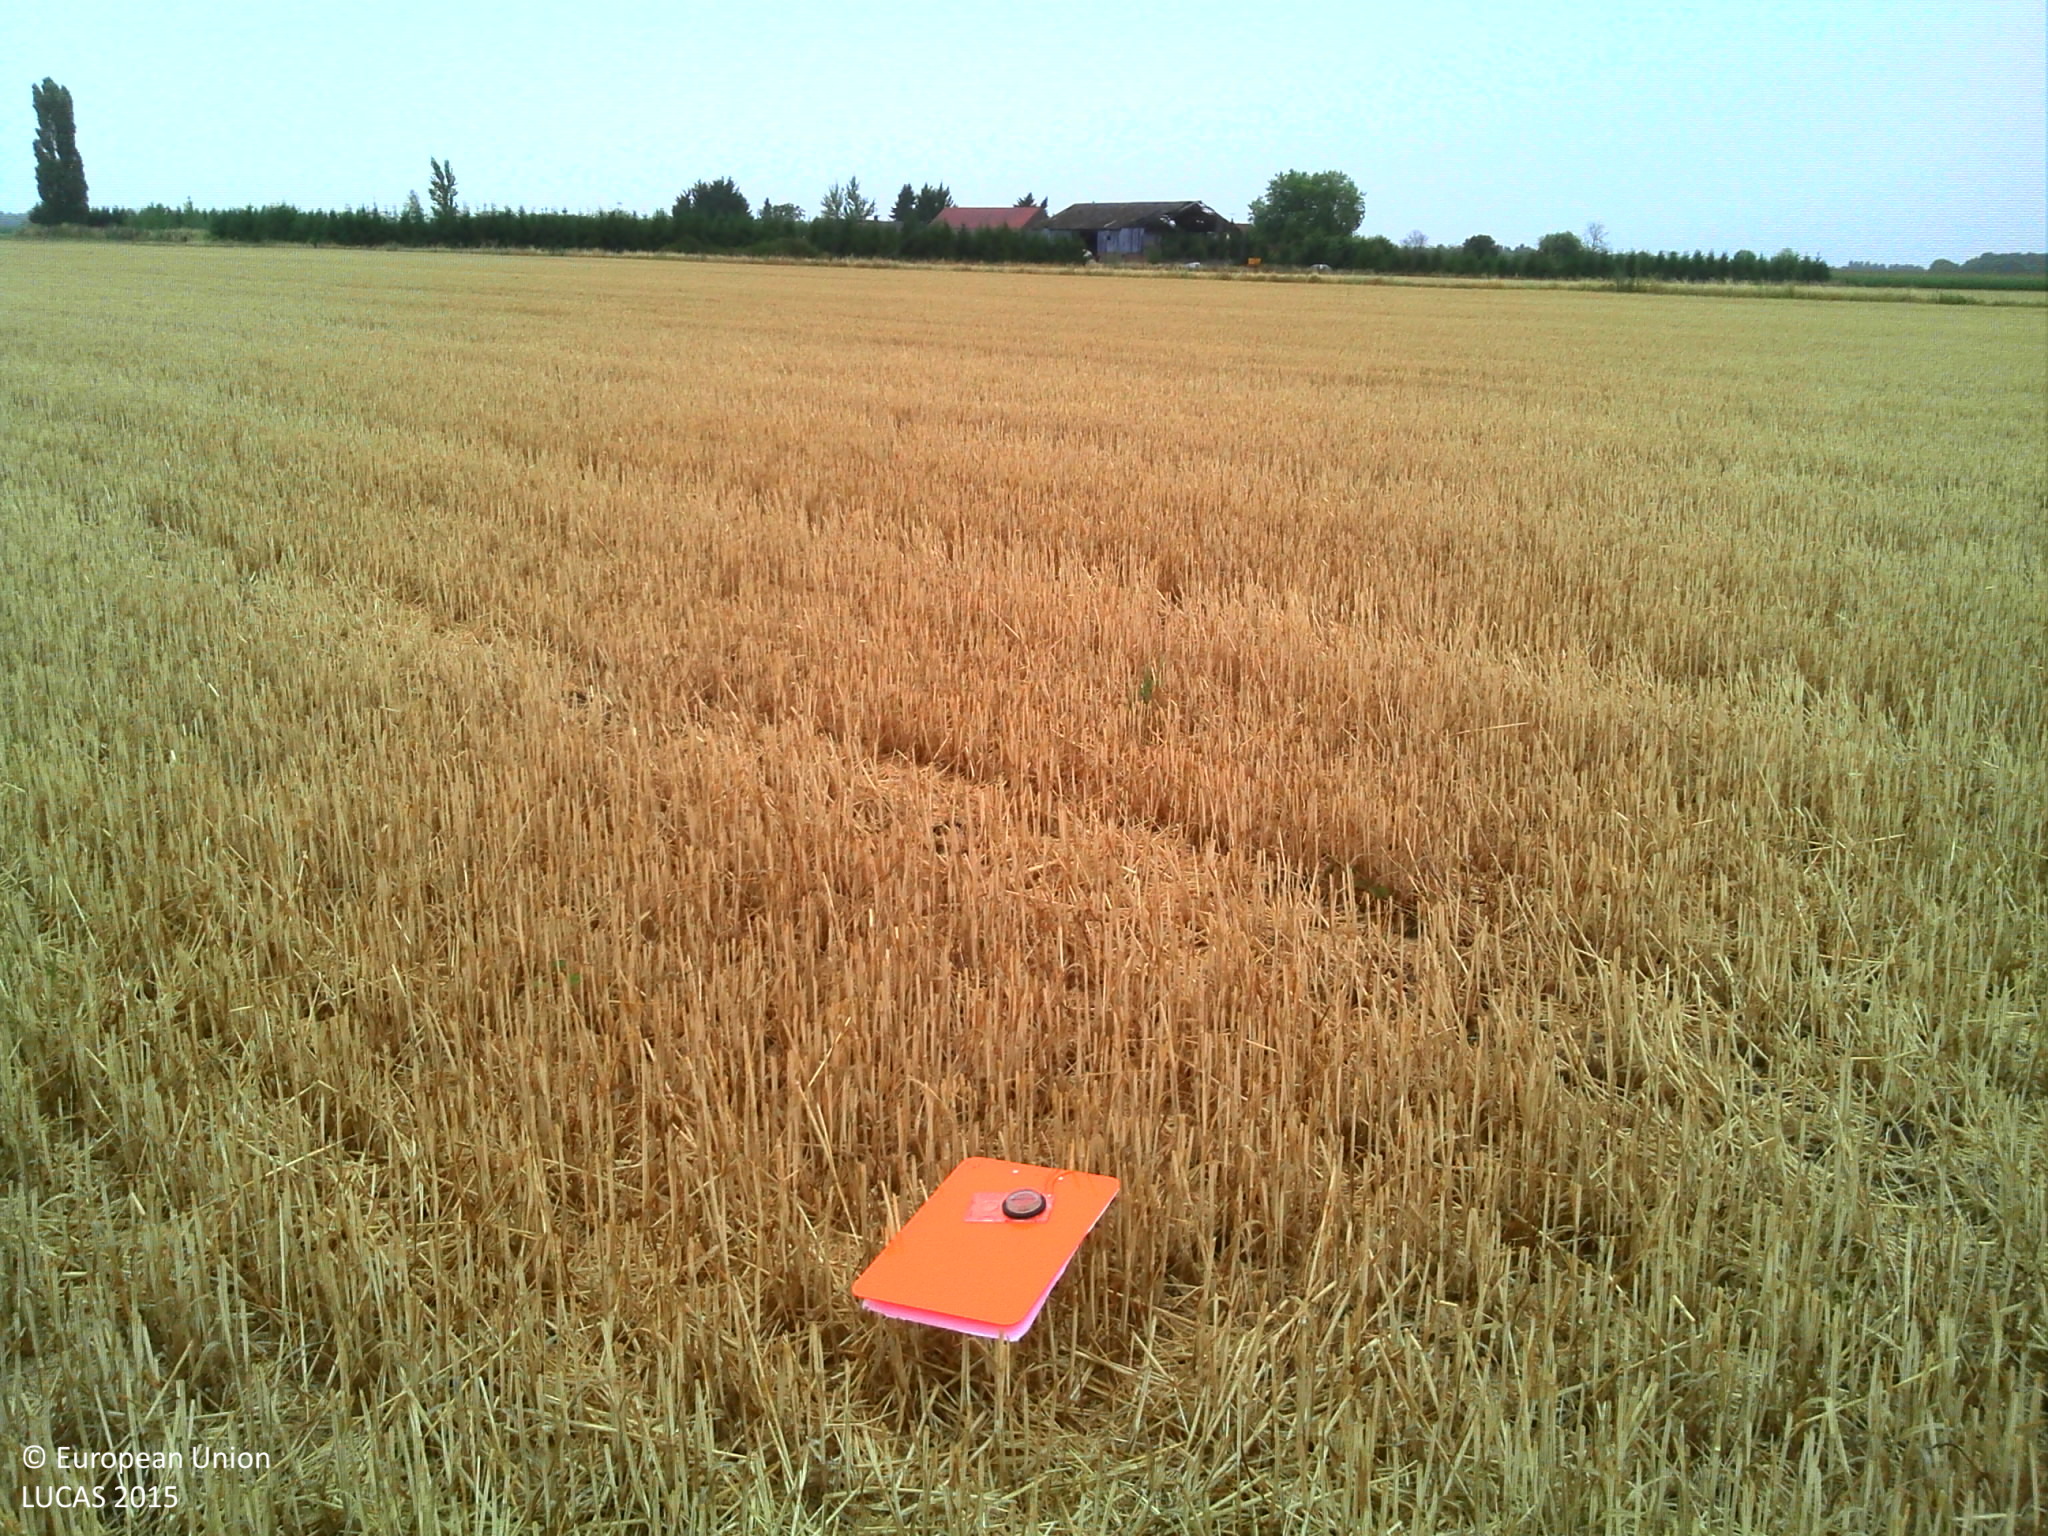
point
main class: Cropland
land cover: Common wheat
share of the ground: > 75 %
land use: Agriculture (excluding fallow land and kitchen gardens)
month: July
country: FR
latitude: 47.8468
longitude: 2.0642
